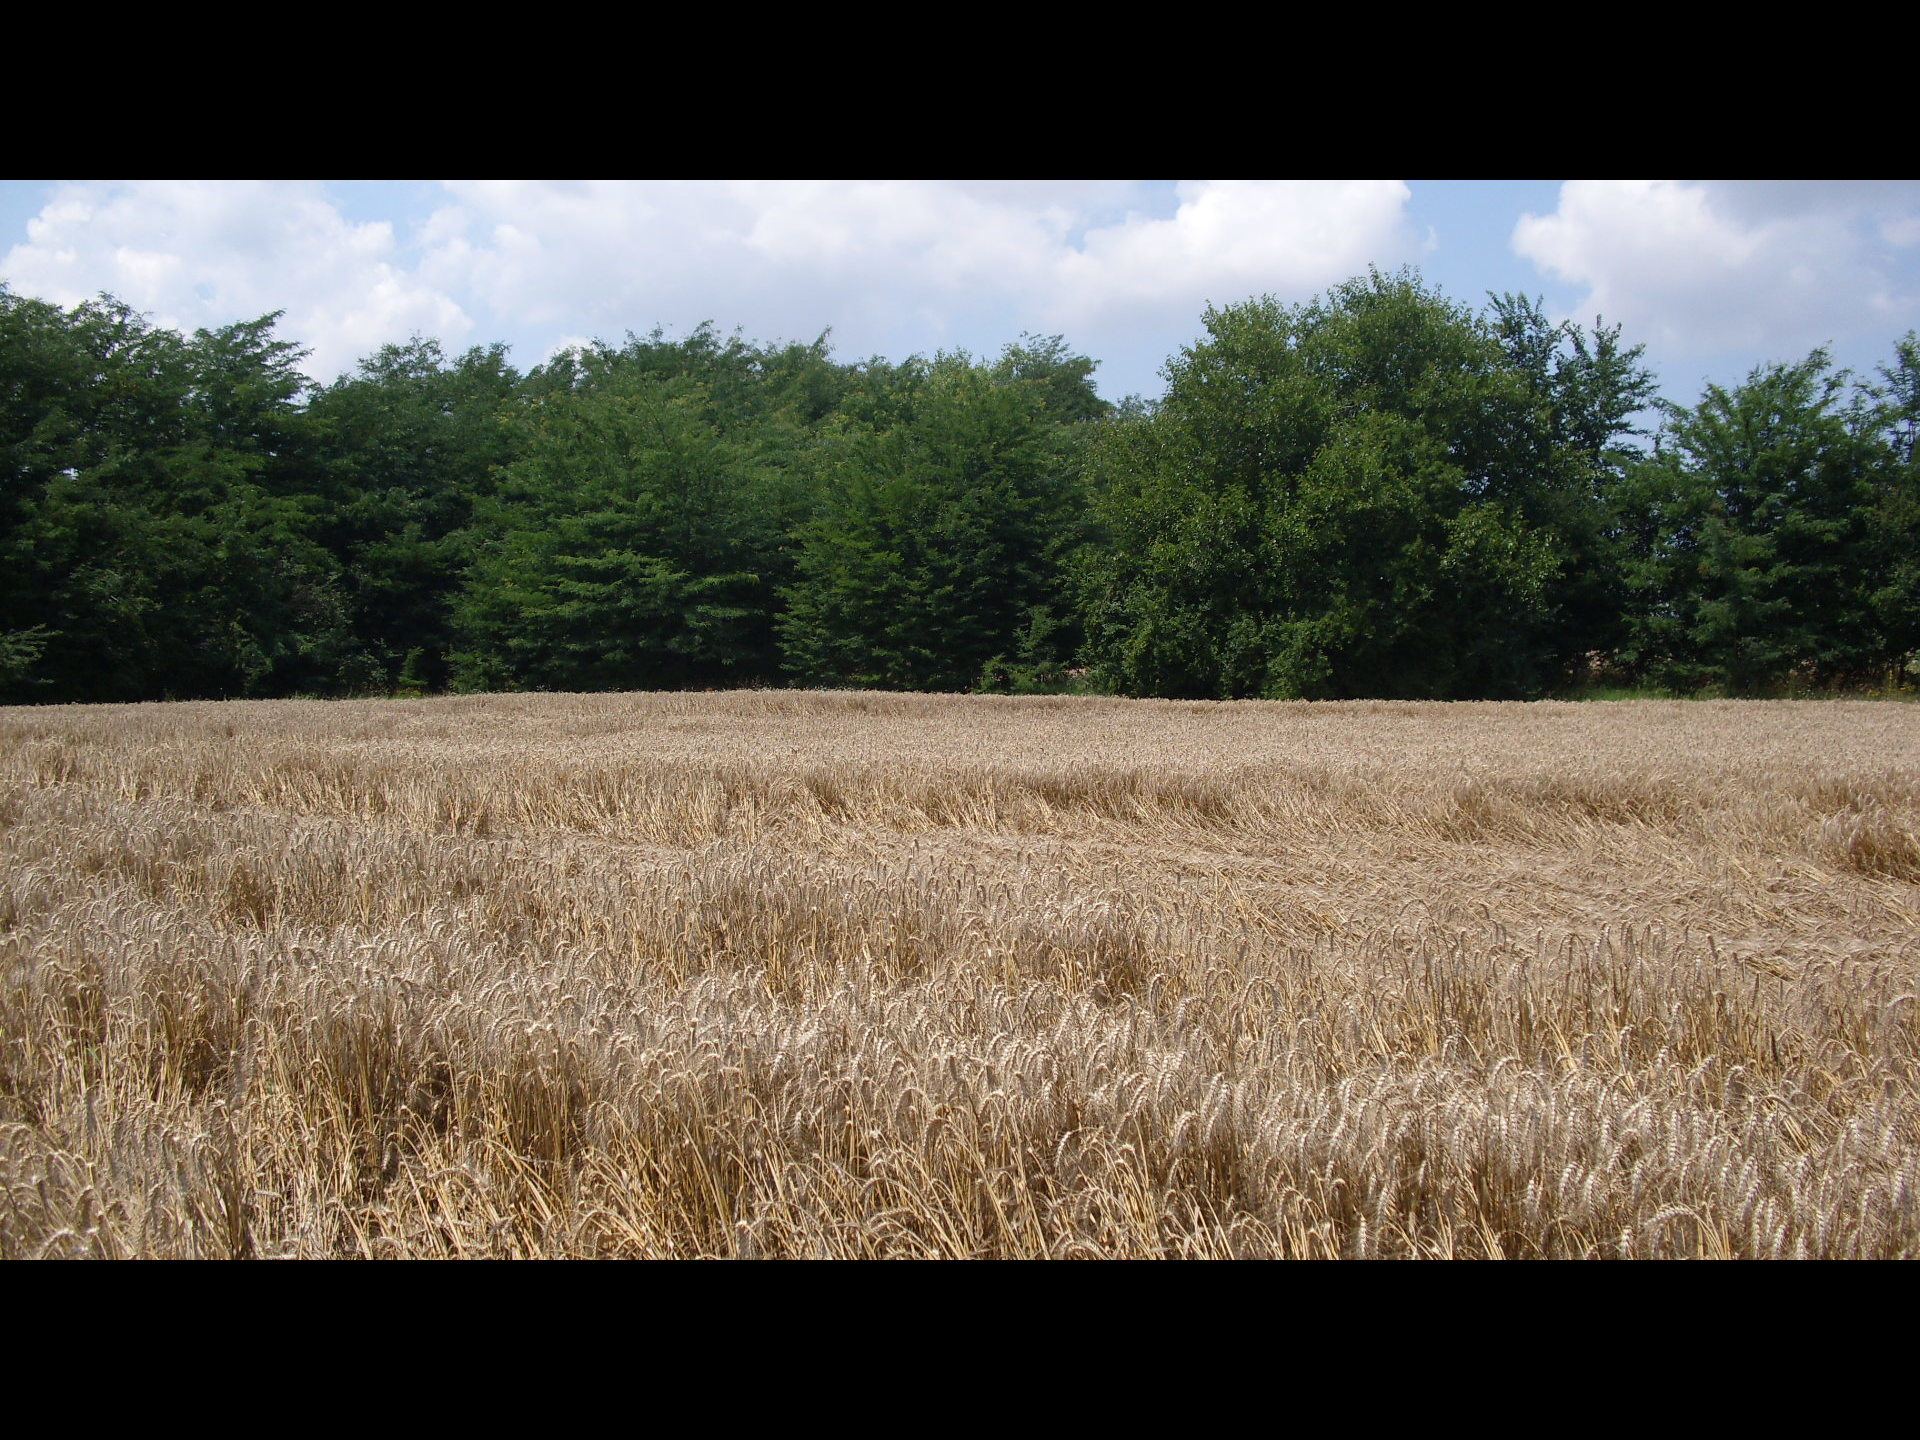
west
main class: Cropland
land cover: Common wheat
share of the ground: > 75 %
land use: Agriculture (excluding fallow land and kitchen gardens)
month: July
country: BG
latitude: 43.7593
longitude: 23.1959
